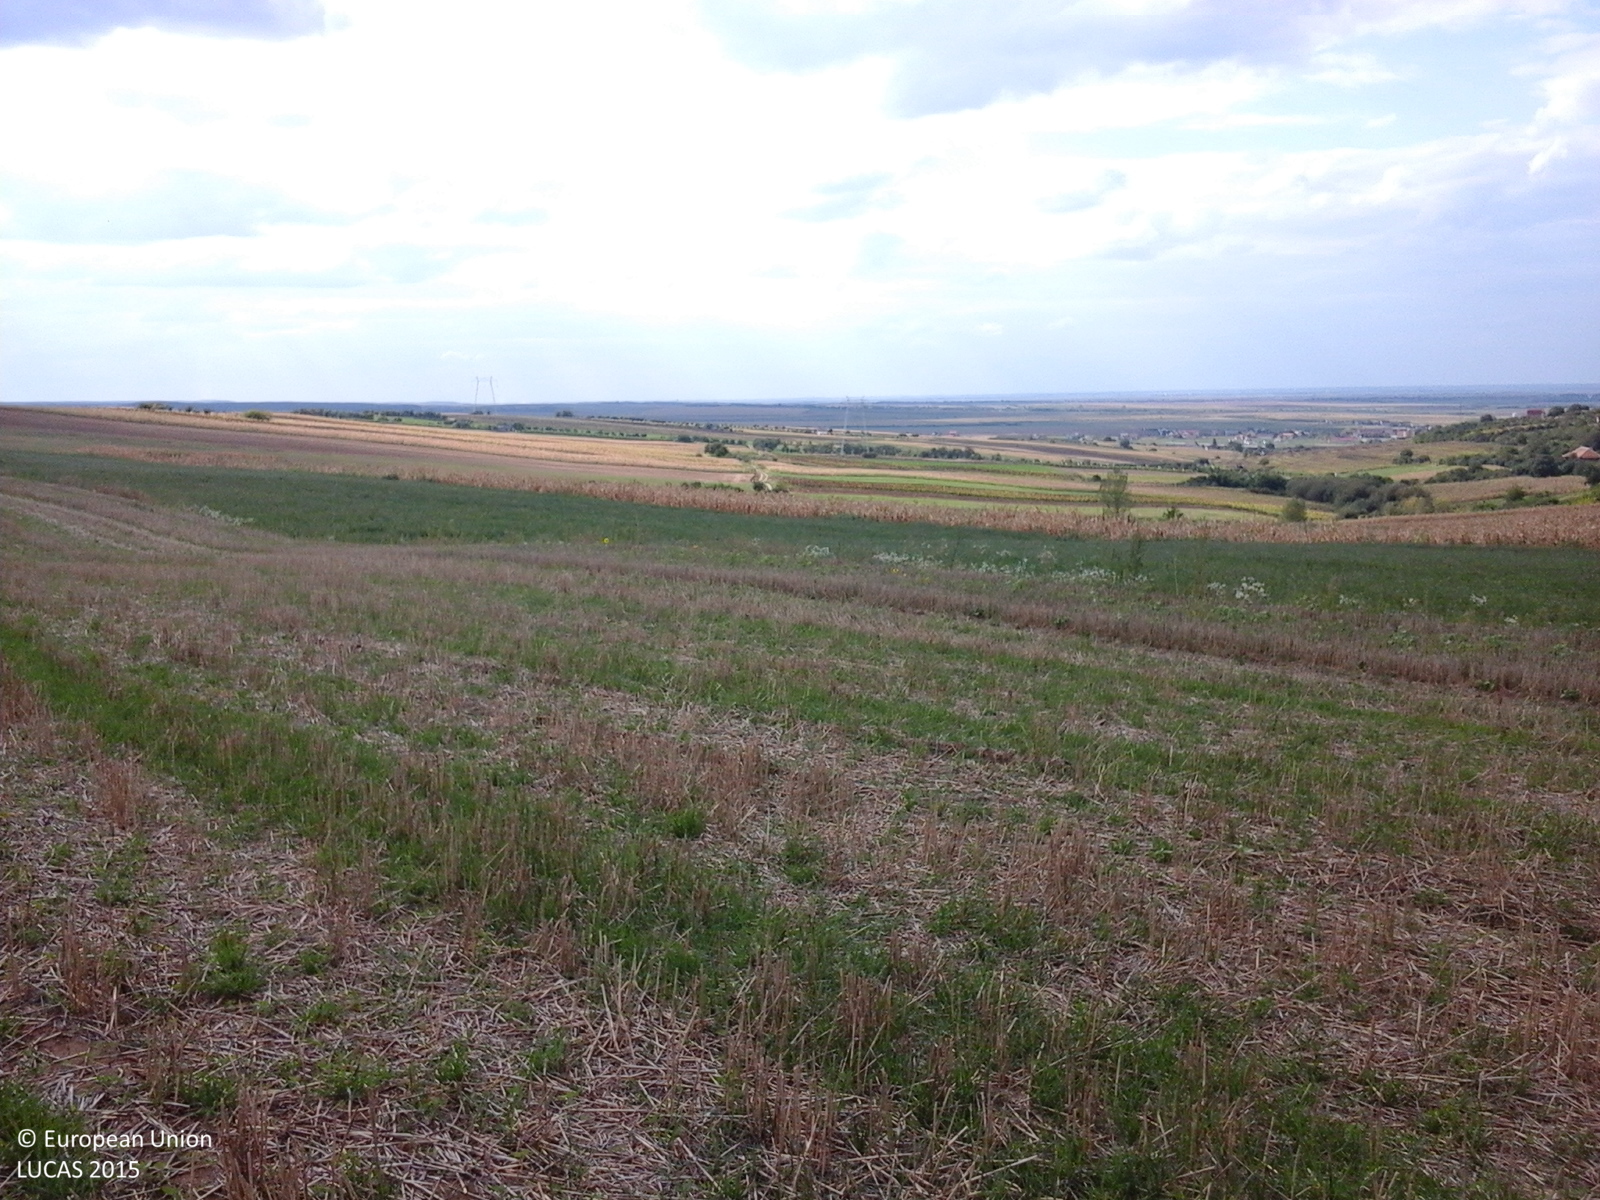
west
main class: Cropland
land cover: Common wheat
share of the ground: 50 - 75 %
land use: Agriculture (excluding fallow land and kitchen gardens)
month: September
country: RO
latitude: 47.4614
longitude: 22.5942
